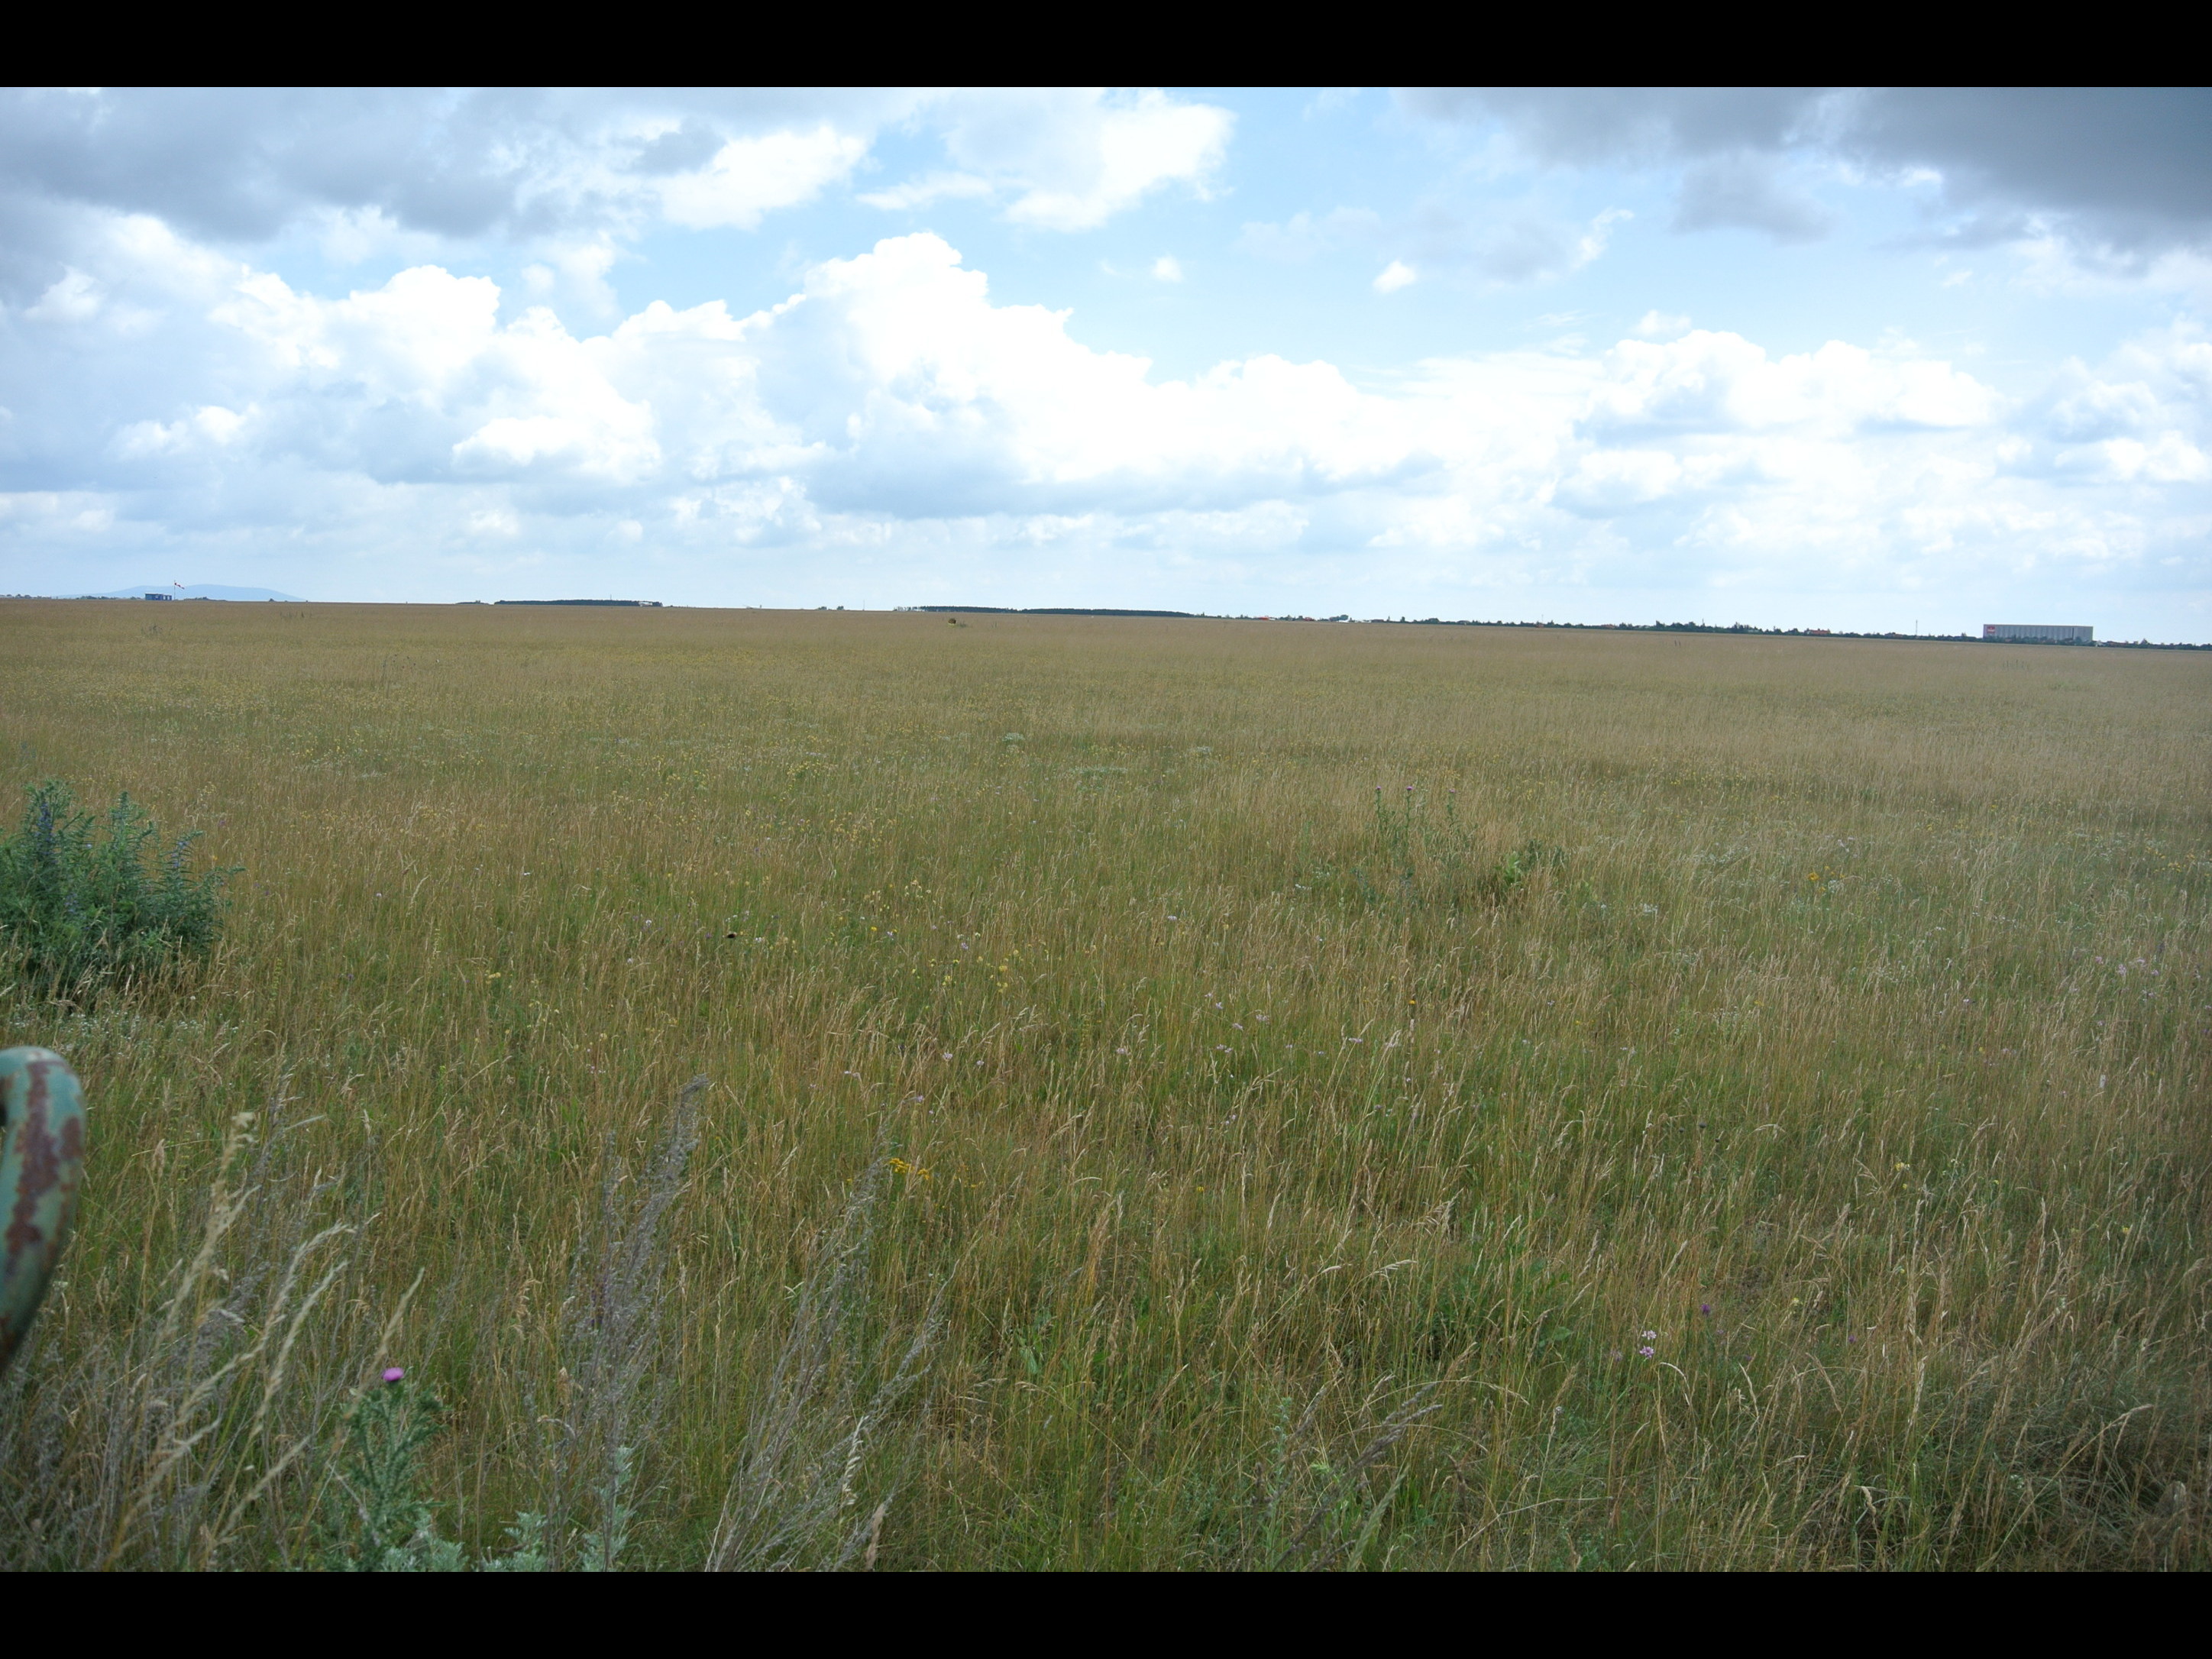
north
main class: Grassland
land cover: Grassland without tree/shrub cover
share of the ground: > 75 %
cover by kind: herbaceous plants 100 %
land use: Air transport
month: June
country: AT
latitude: 47.8316
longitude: 16.2157
